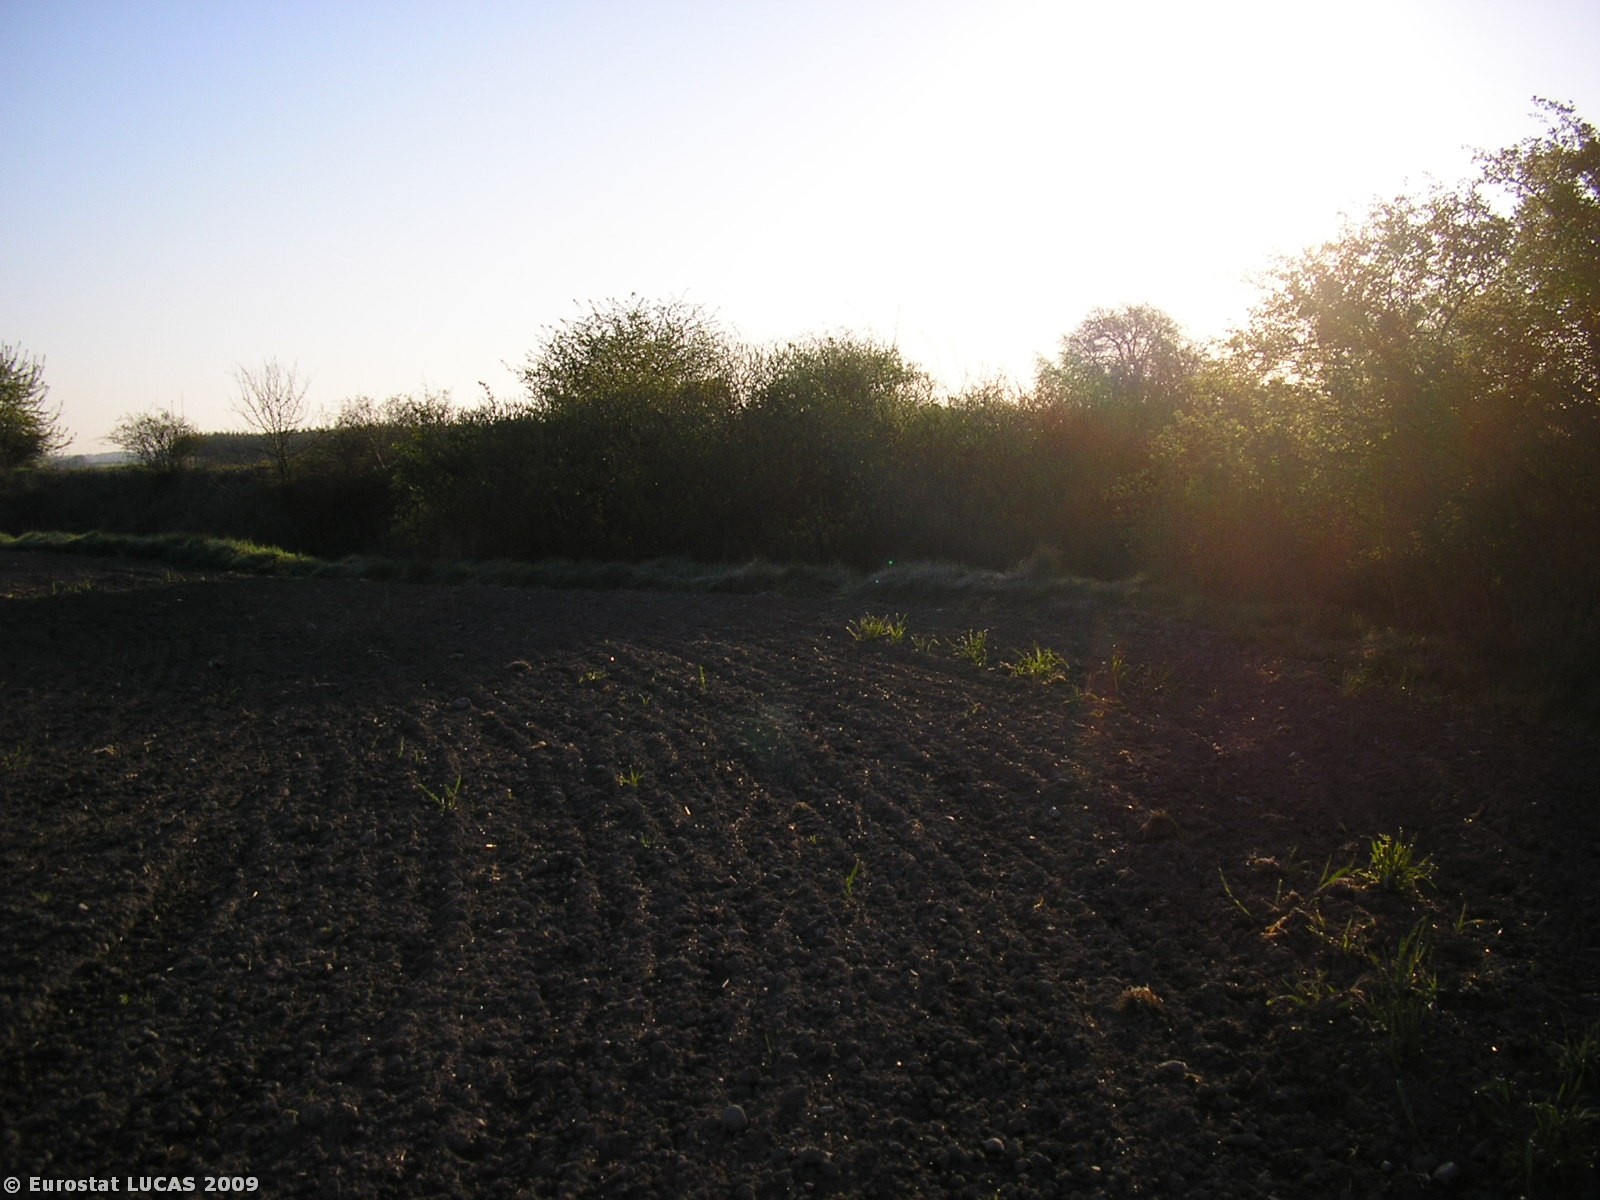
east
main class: Cropland
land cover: Other root crops
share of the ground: < 10 %
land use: Agriculture (excluding fallow land and kitchen gardens)
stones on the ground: < 10 %
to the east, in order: Other root crops; Abandoned hedges; Ditches and canals; Abandoned hedges; Spontaneously vegetated surfaces; Common wheat; Triticale; Maize; Grassland without tree/shrub cover; Apple fruit; Grassland with sparse tree/shrub cover; Grassland without tree/shrub cover; Coniferous woodland
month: April
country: PL
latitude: 52.0737
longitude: 20.0860
